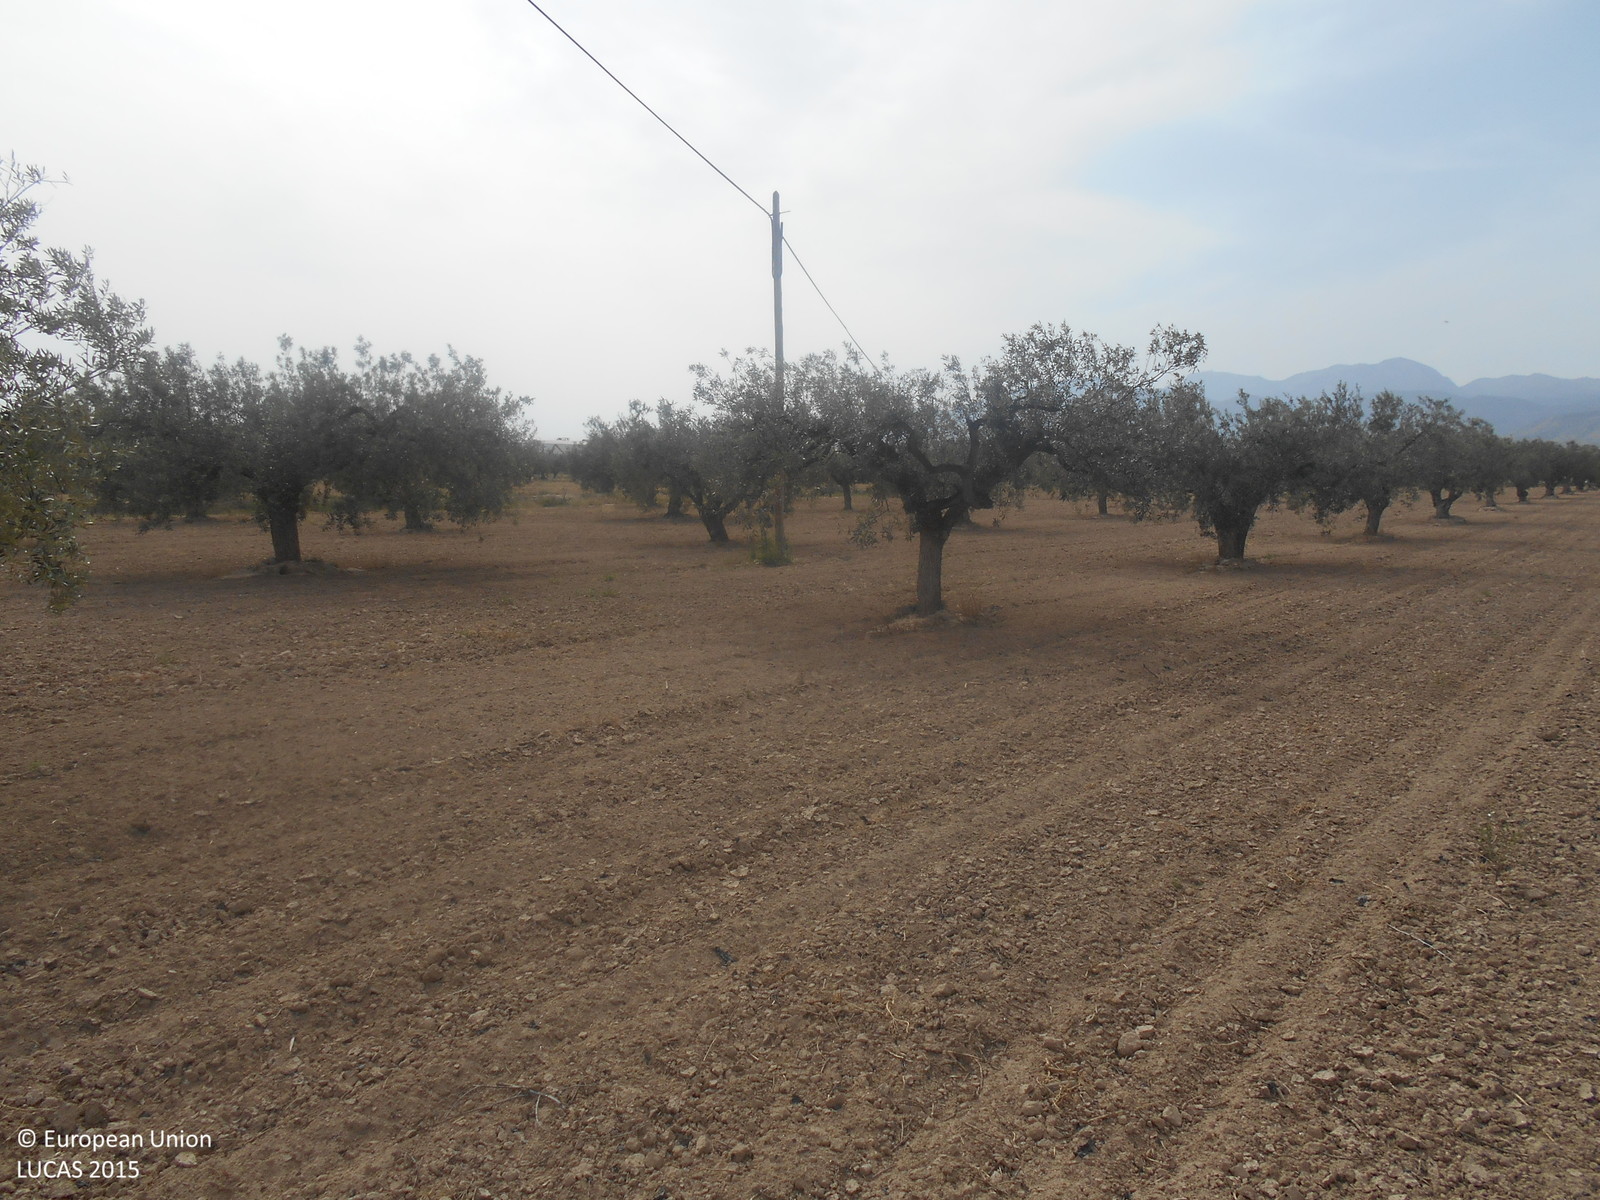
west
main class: Cropland
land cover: Olive groves
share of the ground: > 75 %
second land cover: Other bare soil
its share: > 75 %
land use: Agriculture (excluding fallow land and kitchen gardens)
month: April
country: ES
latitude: 37.8306
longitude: -1.3790
